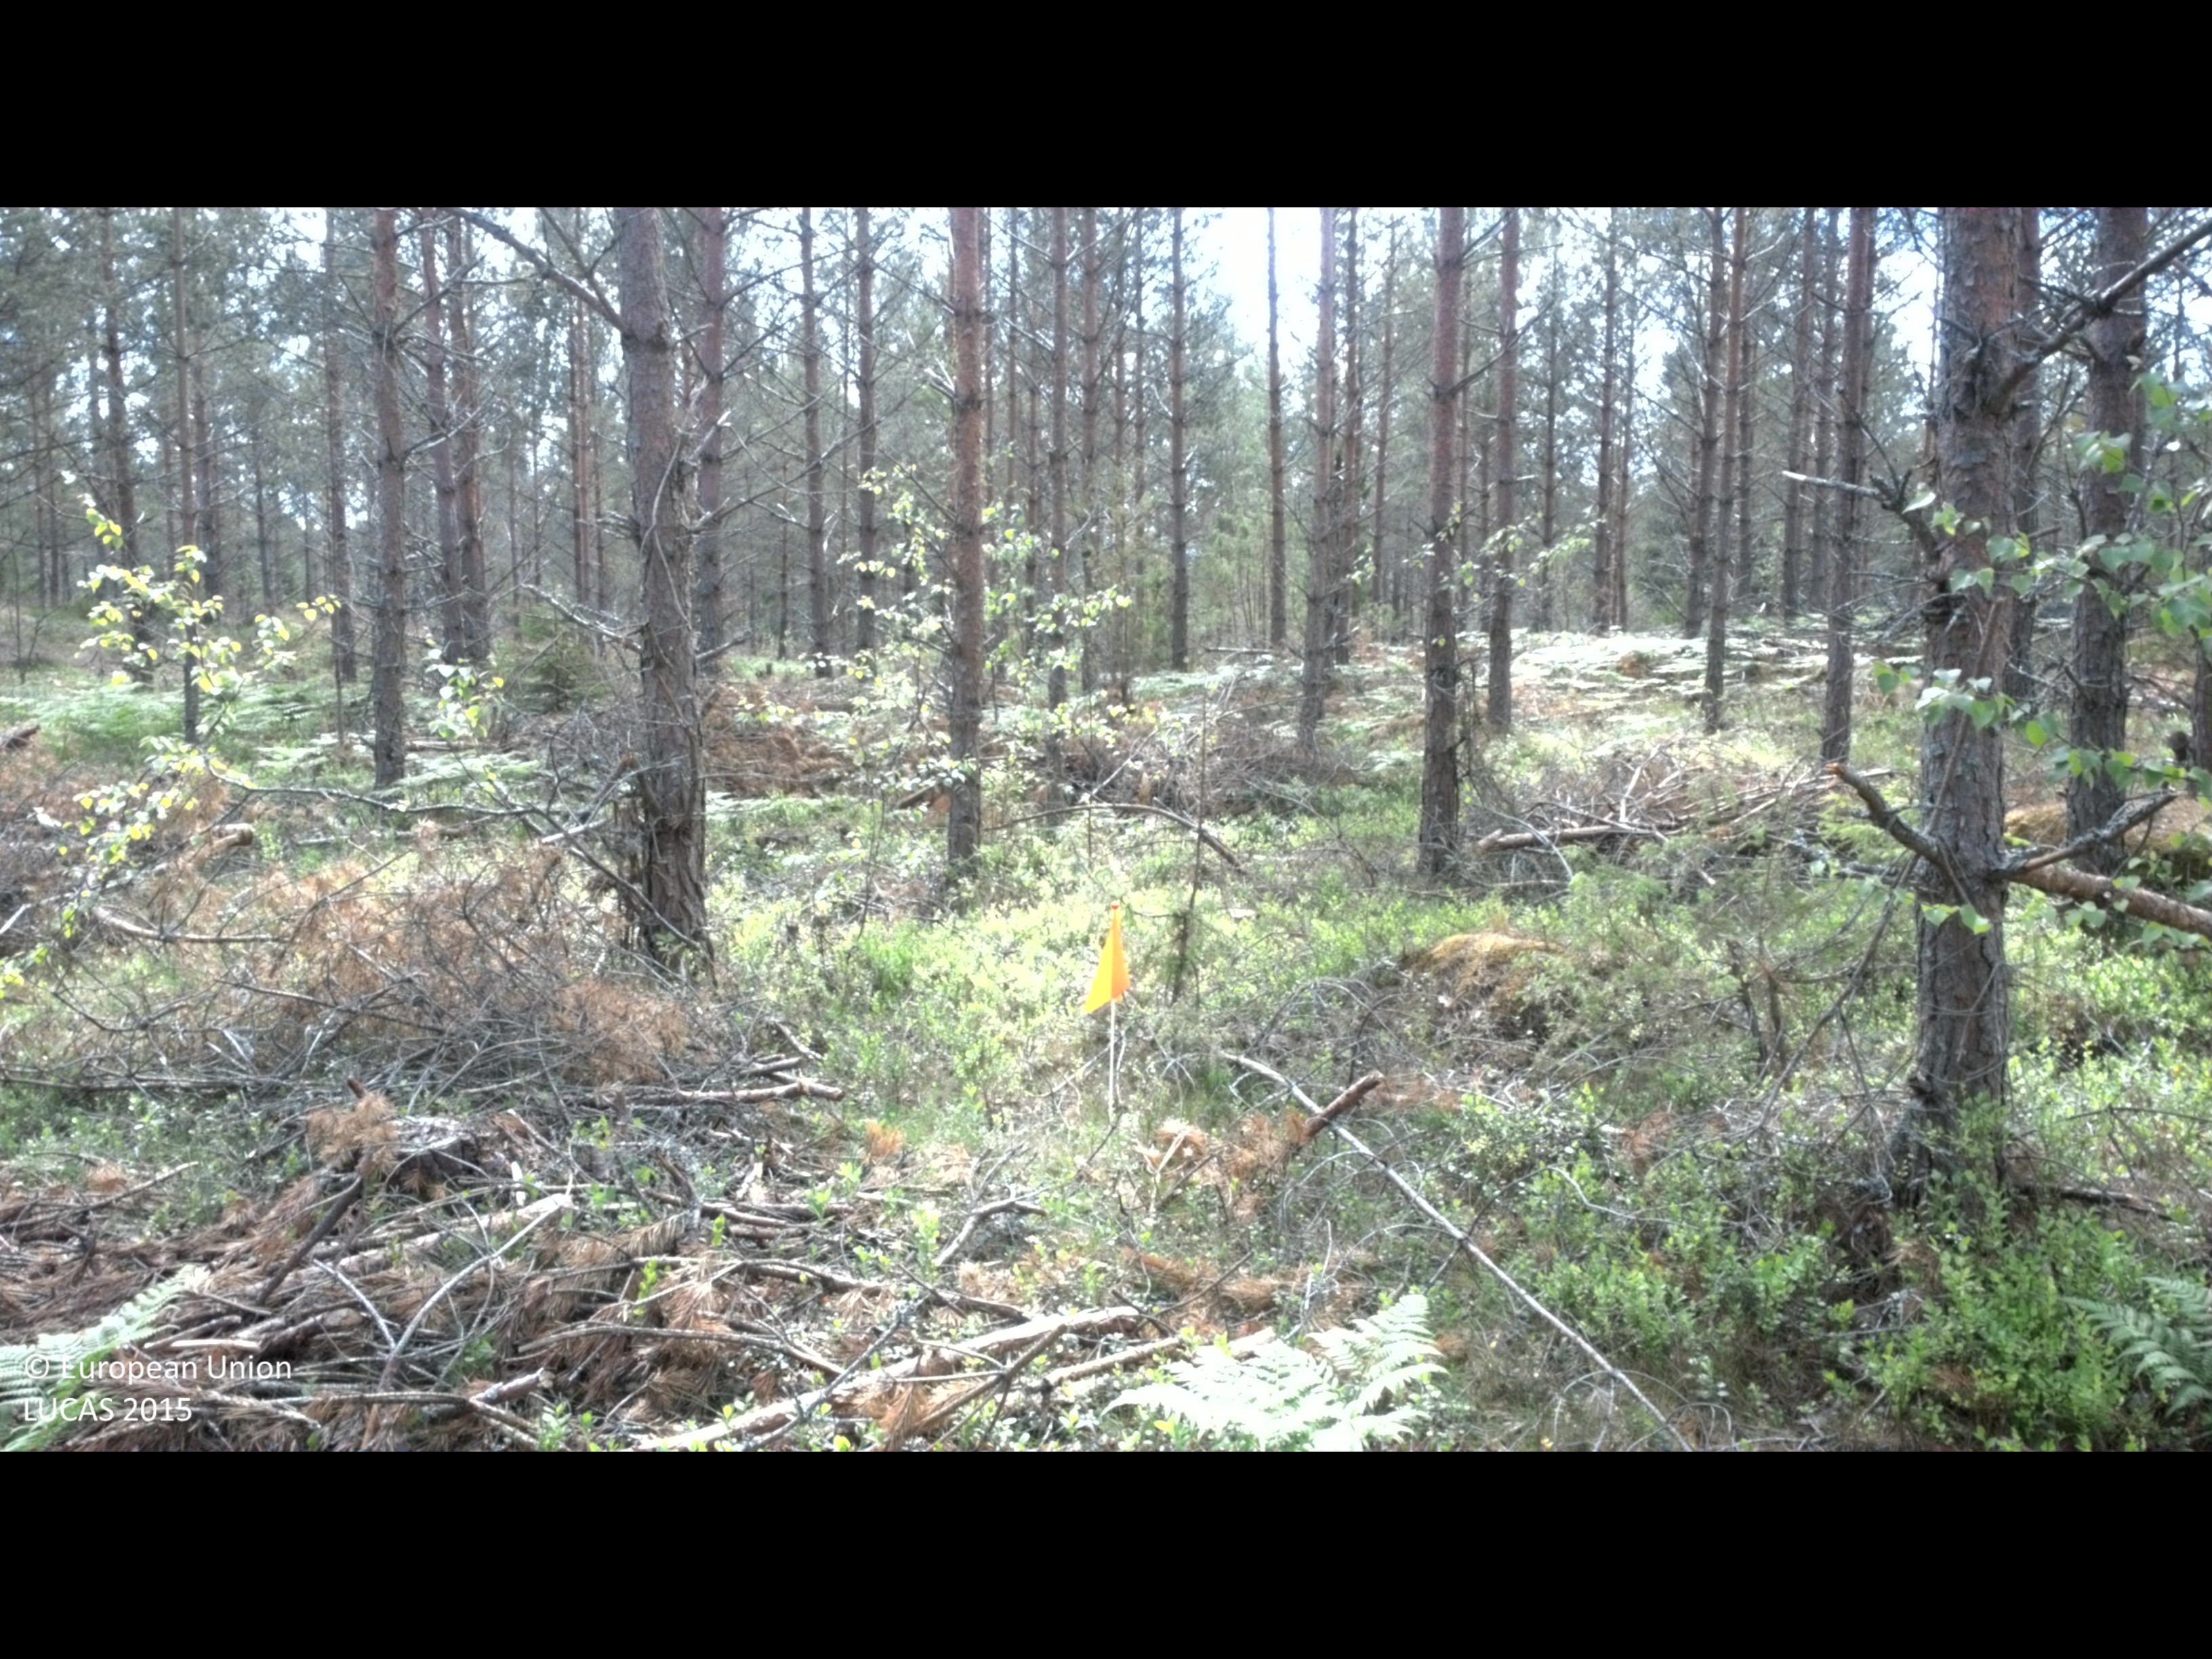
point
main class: Woodland
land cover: Pine dominated coniferous woodland
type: boreal forest
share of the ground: 50 - 75 %
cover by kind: coniferous forest trees 60 %, shrubs 20 %, herbaceous plants 10 %, broadleaved forest trees 5 %, unconsolidated bare surface 5 %
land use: Forestry
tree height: > 5 m
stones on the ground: < 10 %
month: June
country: SE
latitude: 57.7000
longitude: 16.5257
